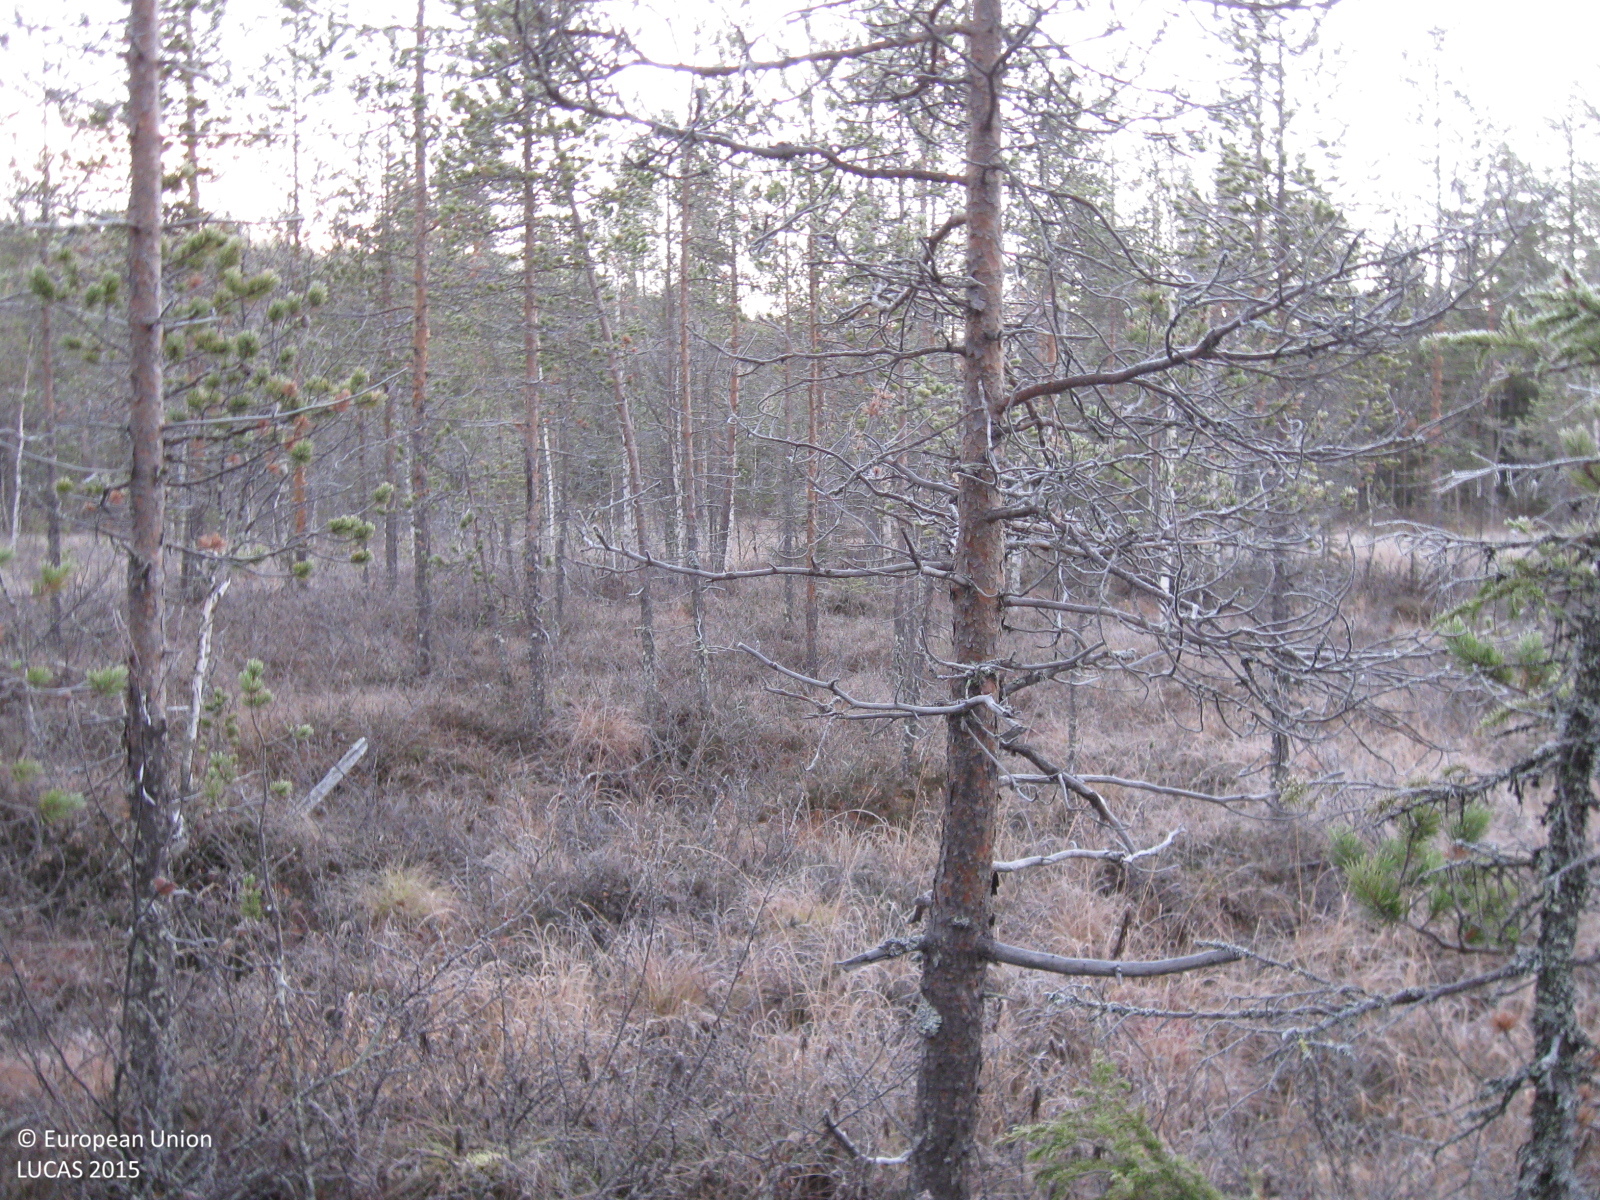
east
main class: Woodland
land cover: Pine dominated coniferous woodland
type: mire and swamp forests
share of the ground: 50 - 75 %
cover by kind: coniferous forest trees 45 %, shrubs 25 %, herbaceous plants 15 %, broadleaved forest trees 10 %, lichens and mosses 5 %
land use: Semi-natural and natural areas not in use
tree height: > 5 m
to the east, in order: Pine dominated coniferous woodland; Rivers and streams; Pine dominated mixed woodland; Tracks; Spruce dominated mixed woodland; Pine dominated mixed woodland
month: October
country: SE
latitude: 66.1488
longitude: 22.1397
